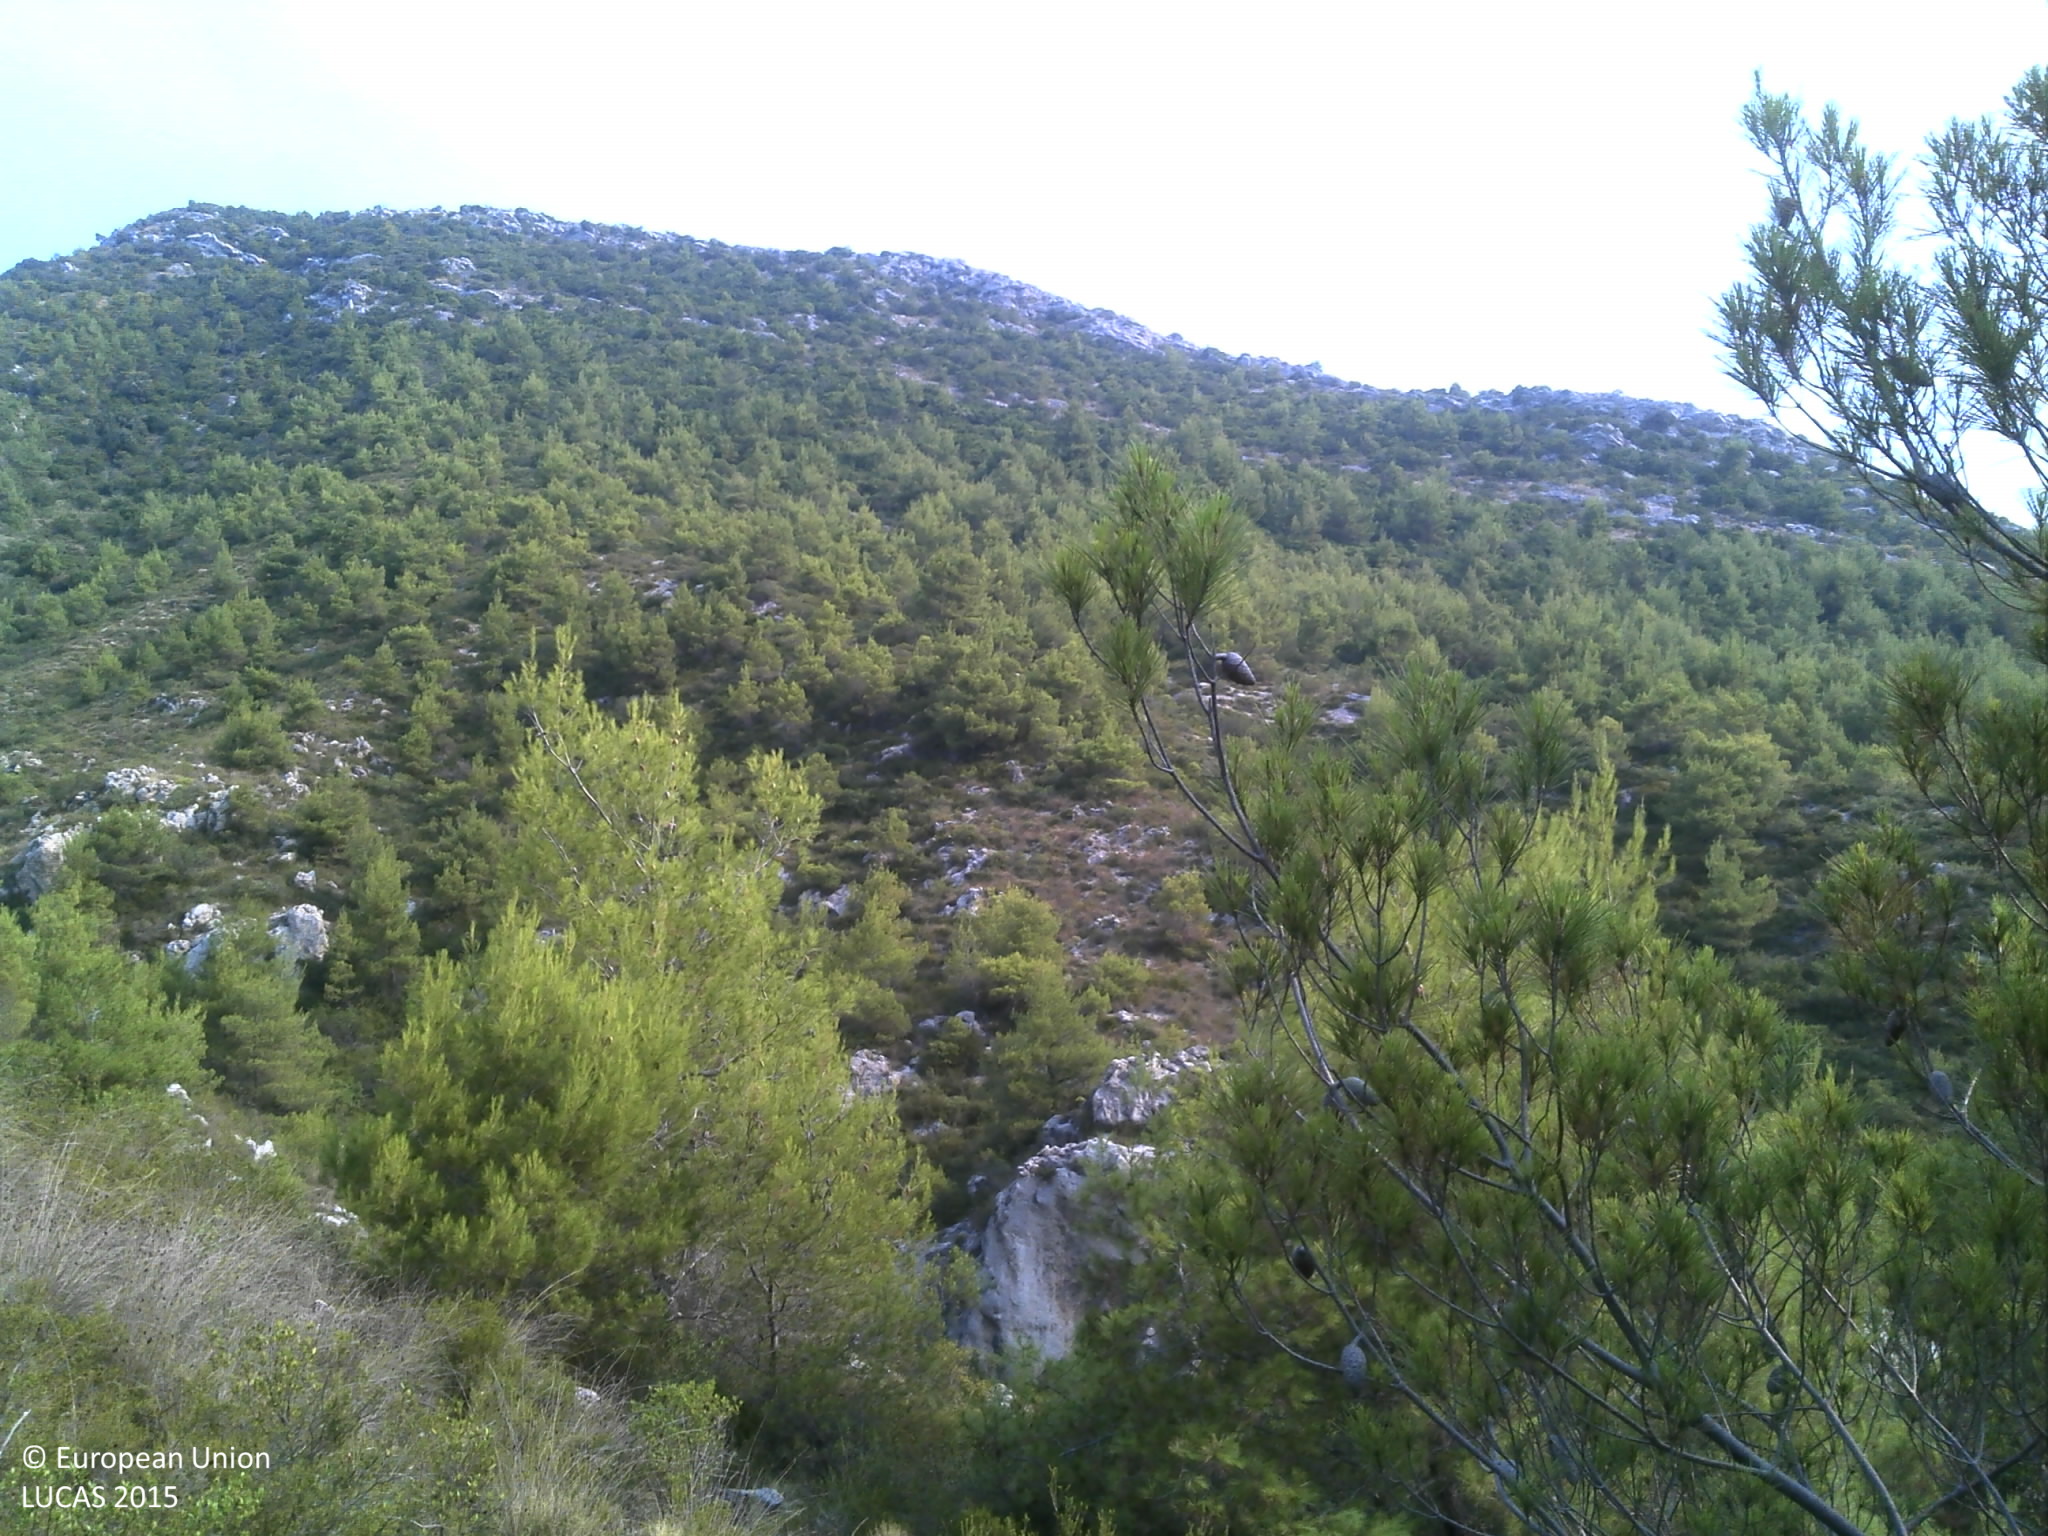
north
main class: Woodland
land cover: Pine dominated coniferous woodland
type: coniferous forest of the mediterranean region
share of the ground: > 75 %
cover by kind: coniferous forest trees 60 %, shrubs 20 %, consolidated bare surface 10 %, unconsolidated bare surface 10 %
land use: Semi-natural and natural areas not in use
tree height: > 5 m
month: July
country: HR
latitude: 42.8134
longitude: 17.7070
